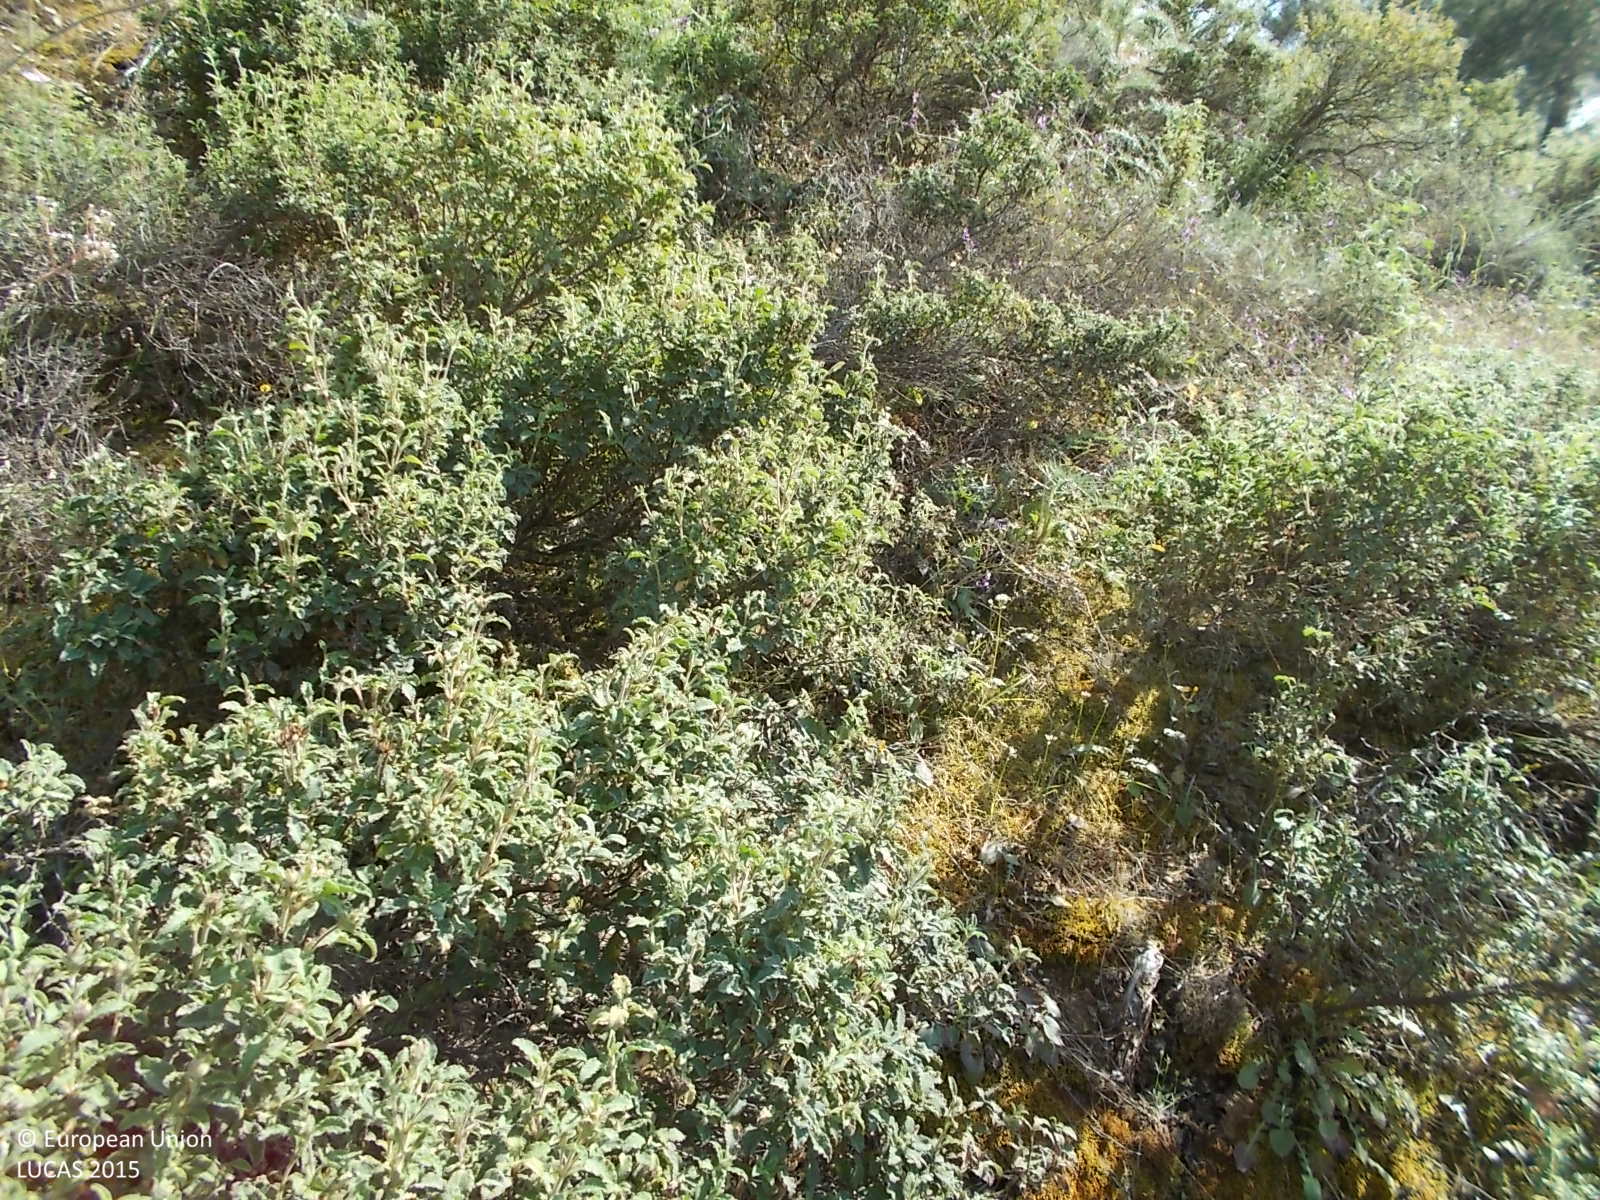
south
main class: Woodland
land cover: Pine dominated coniferous woodland
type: coniferous forest of the mediterranean region
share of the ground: 10 - 25 %
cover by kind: shrubs 40 %, herbaceous plants 35 %, coniferous forest trees 15 %, unconsolidated bare surface 10 %
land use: Forestry
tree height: > 5 m
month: May
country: CY
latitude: 34.9795
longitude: 33.0812
